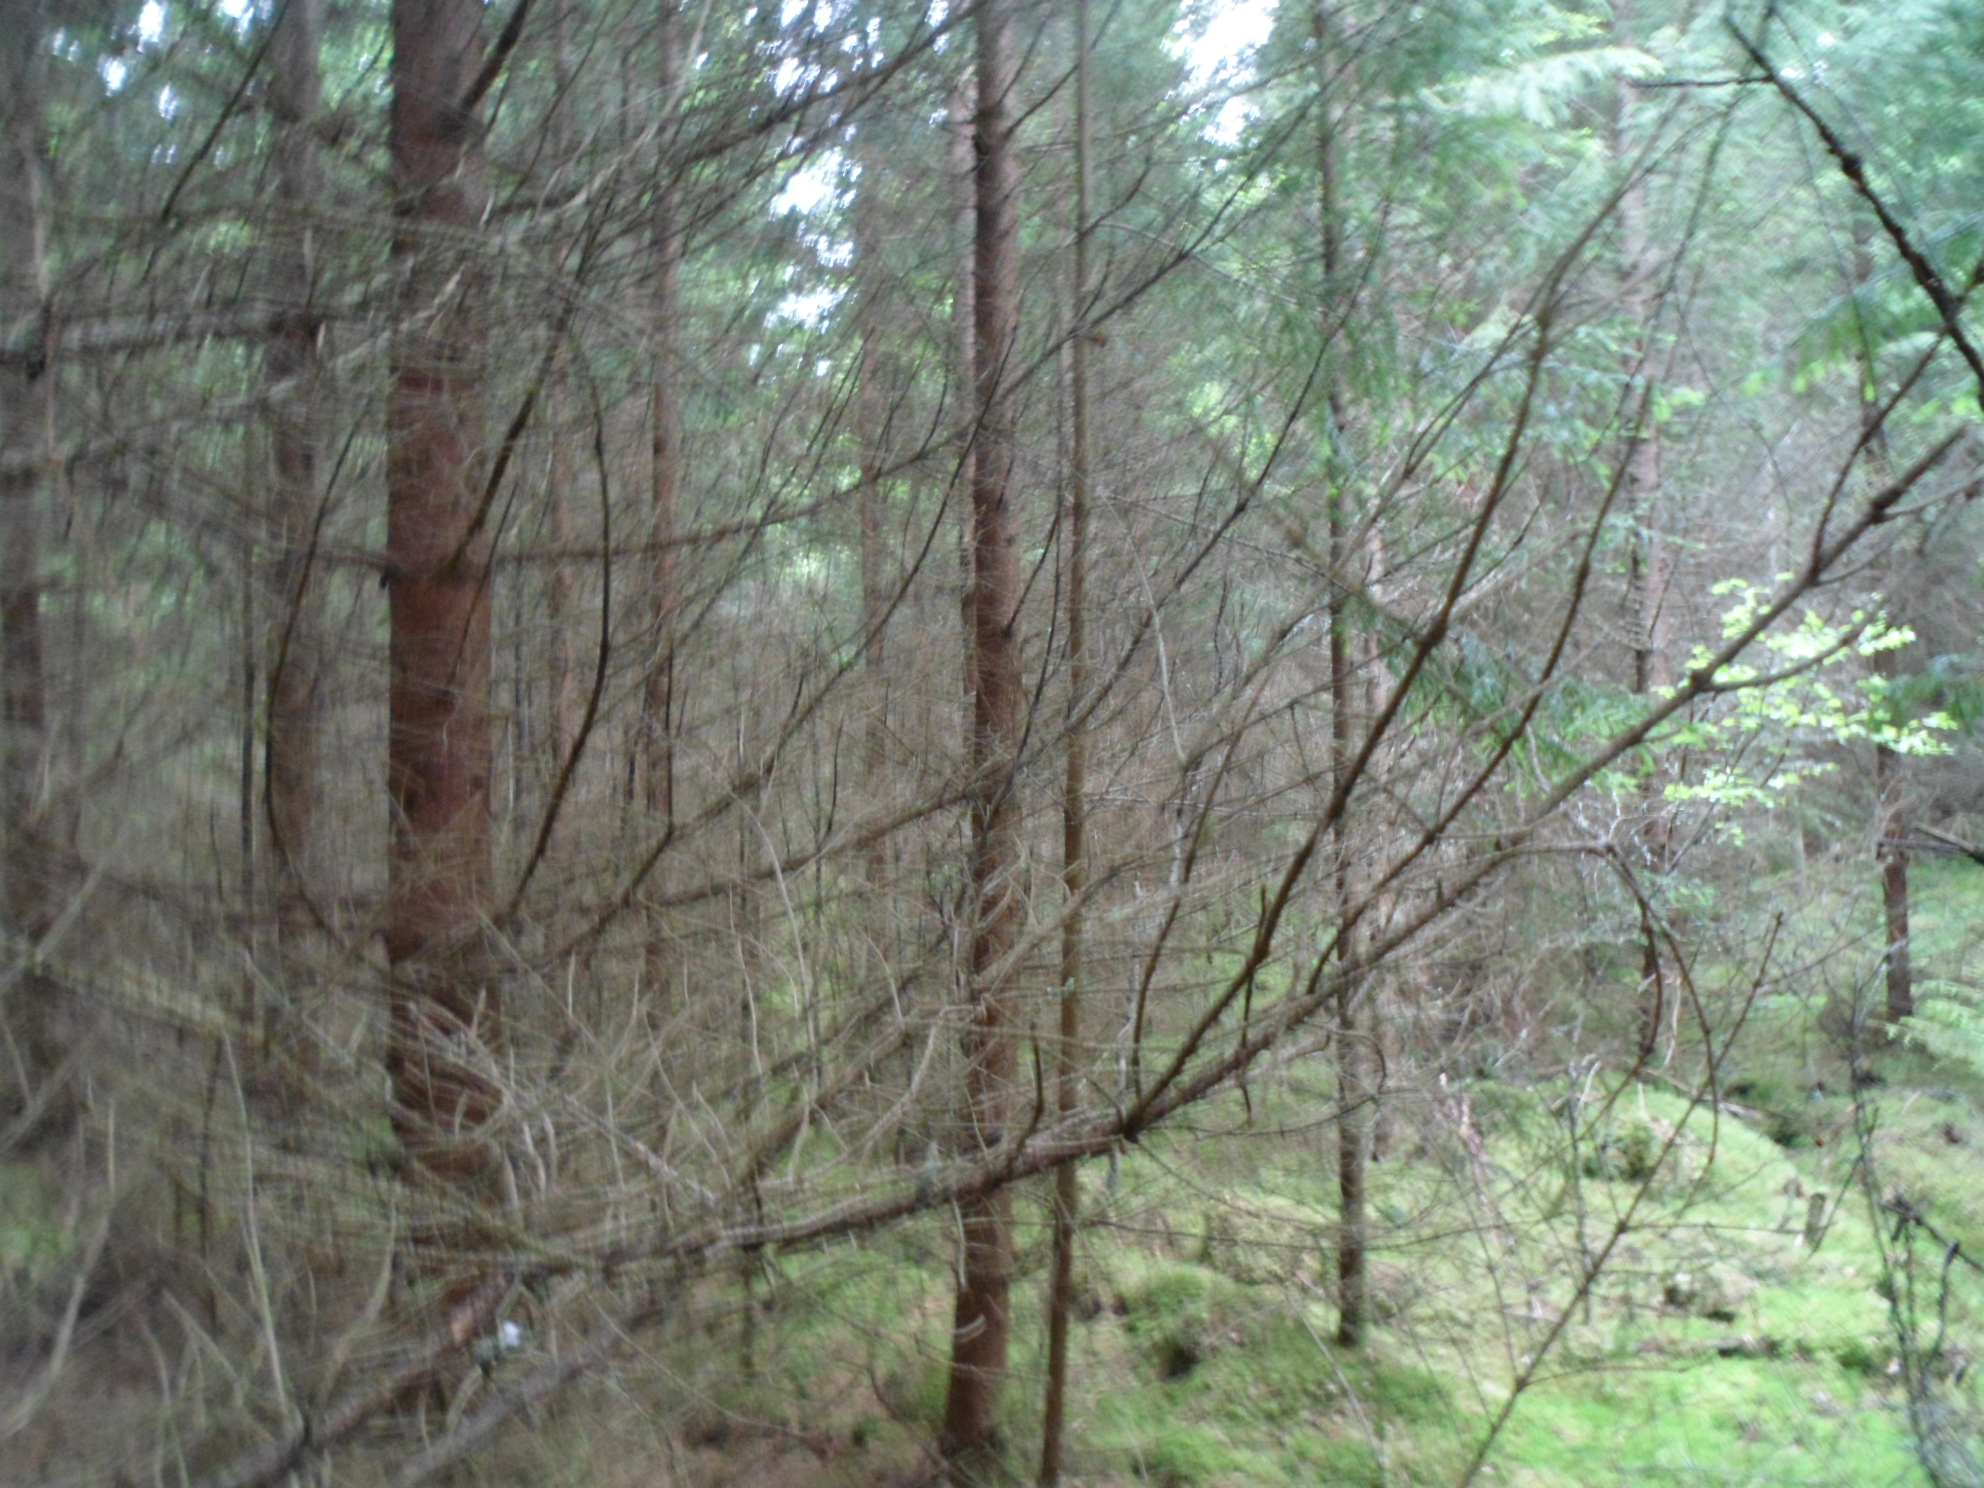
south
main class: Woodland
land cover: Spruce dominated coniferous woodland
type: boreal forest
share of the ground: > 75 %
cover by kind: coniferous forest trees 75 %, lichens and mosses 10 %, broadleaved forest trees 5 %, shrubs 5 %, herbaceous plants 5 %
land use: Forestry
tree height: > 5 m
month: June
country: SE
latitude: 57.1302
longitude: 14.1098
